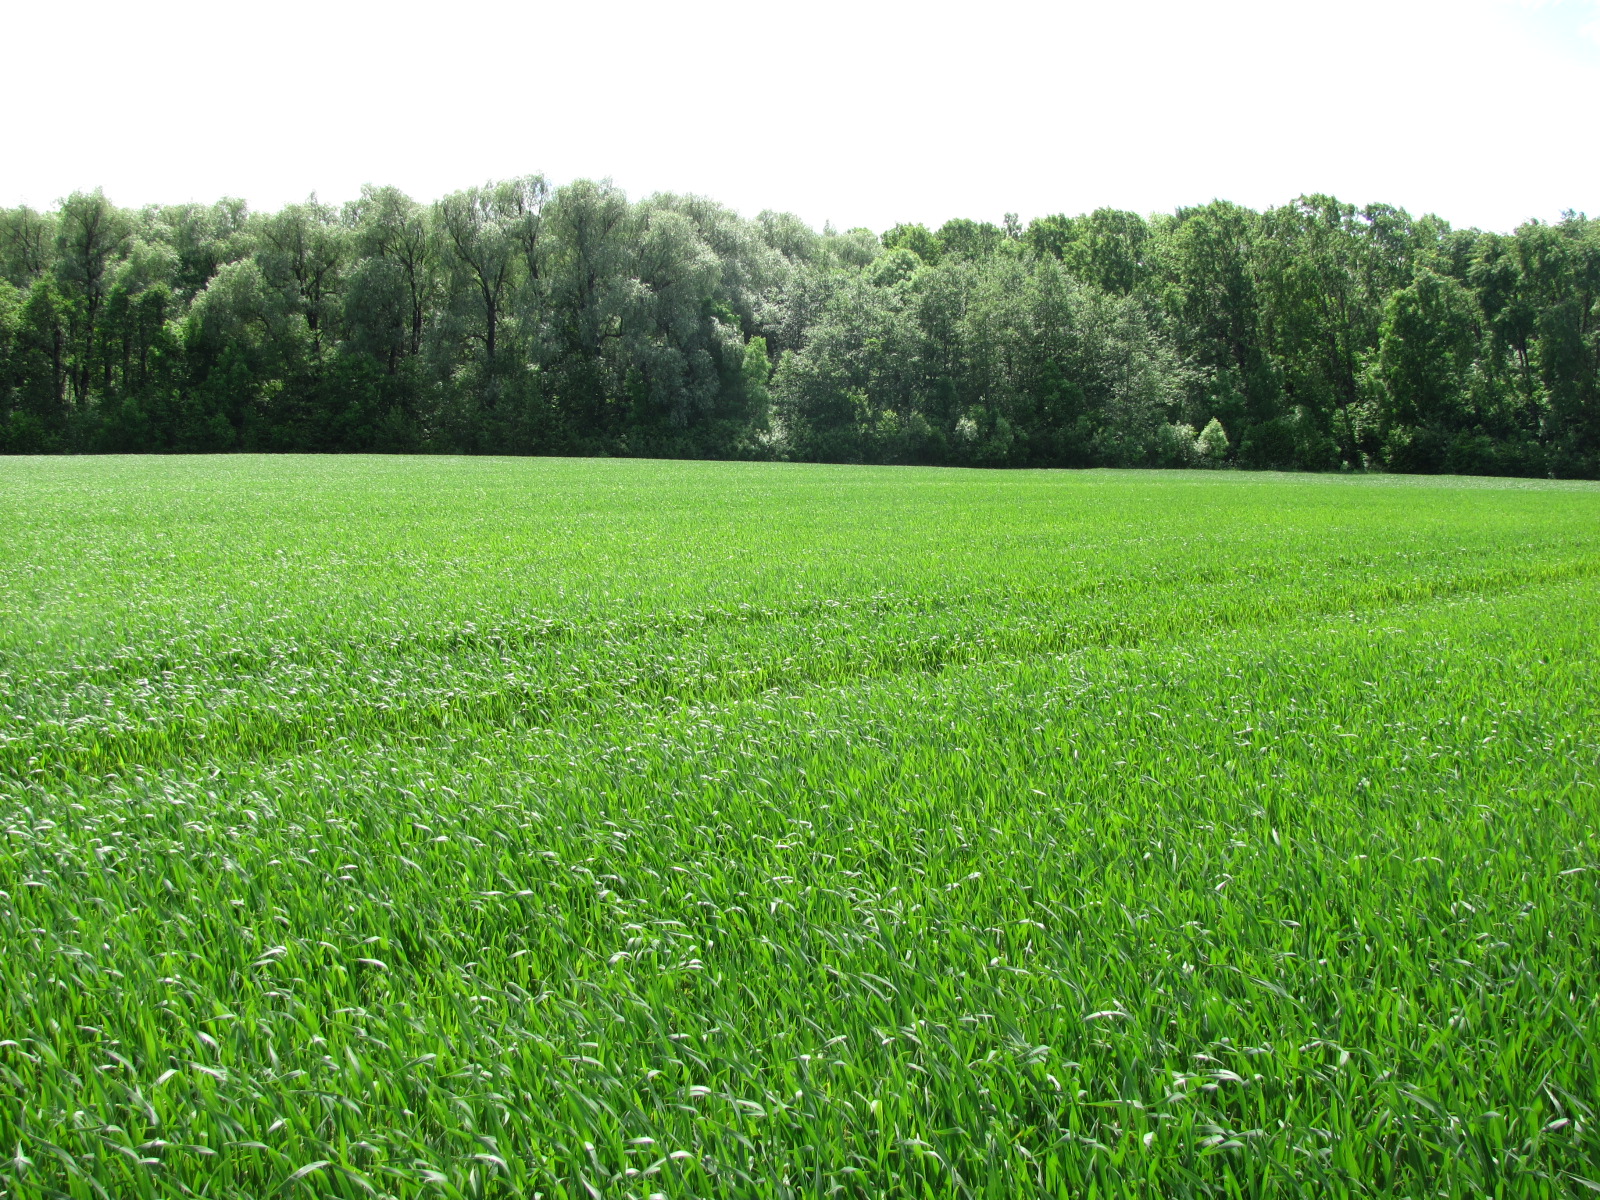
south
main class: Cropland
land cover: Common wheat
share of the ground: > 75 %
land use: Agriculture (excluding fallow land and kitchen gardens)
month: June
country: LV
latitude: 56.2718
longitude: 24.1877
